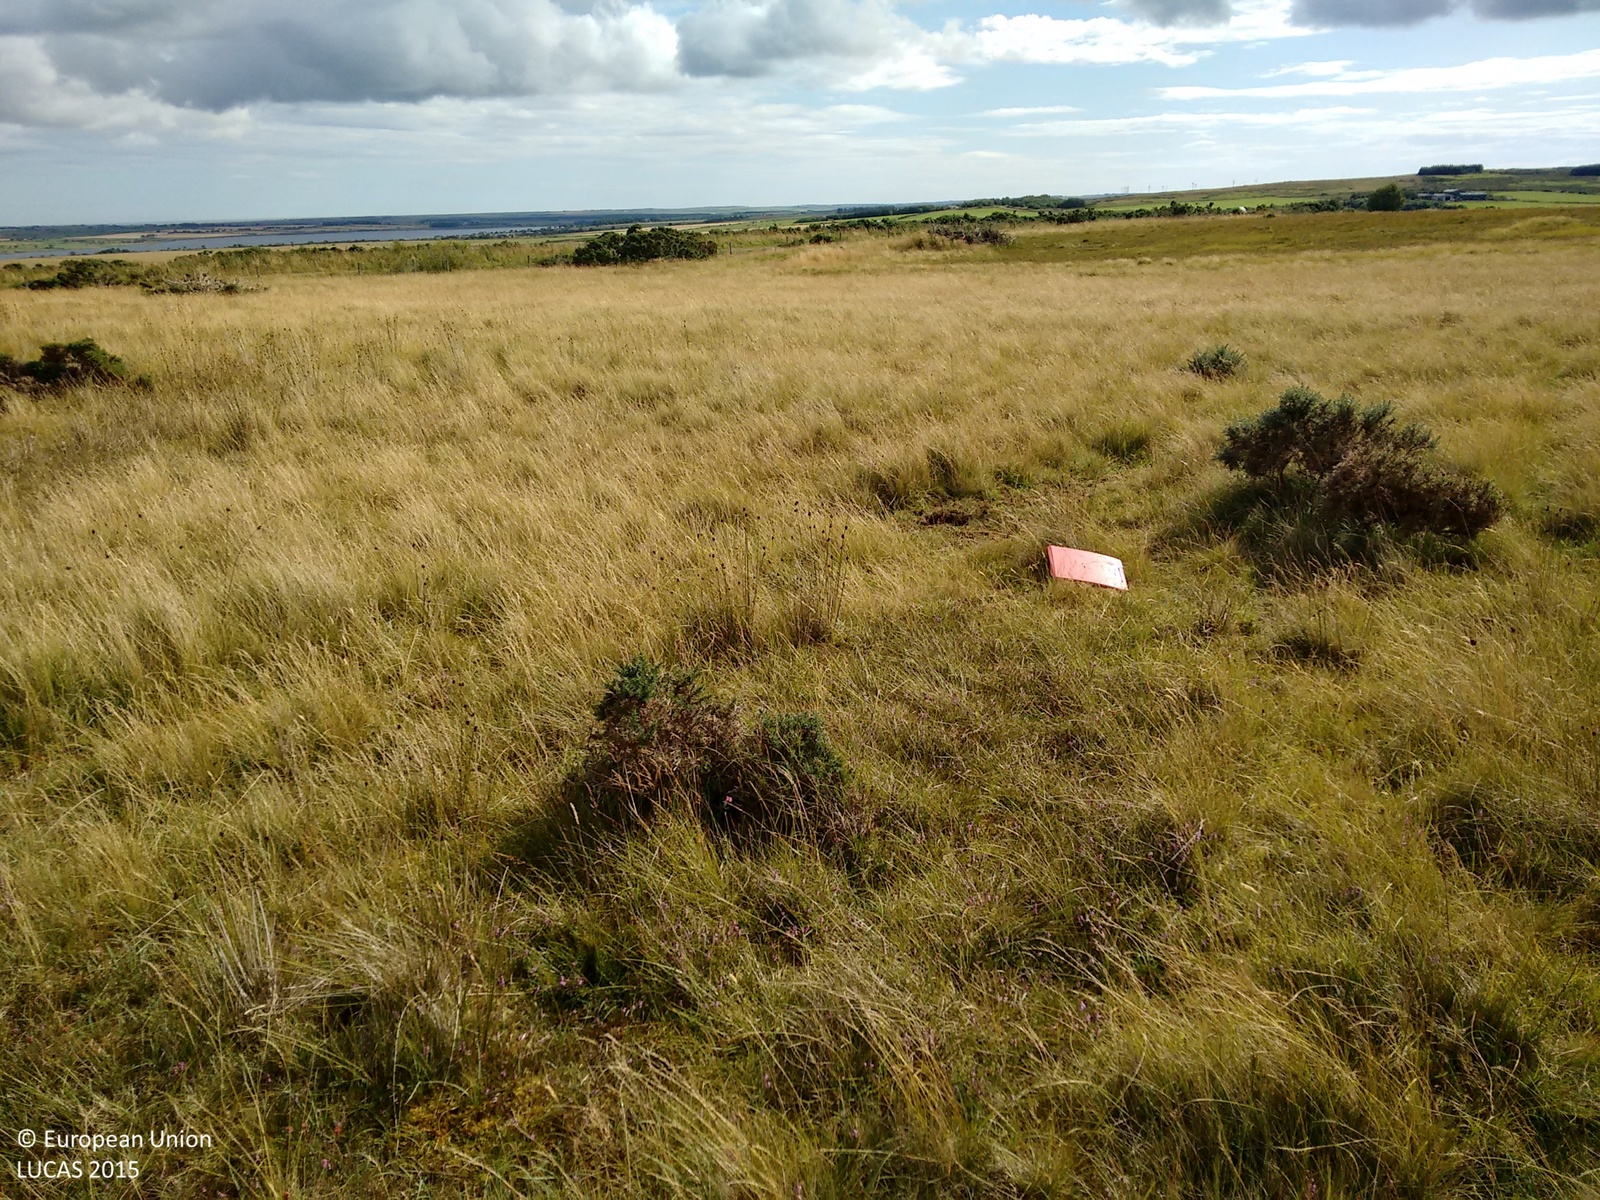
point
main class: Grassland
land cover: Grassland without tree/shrub cover
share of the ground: > 75 %
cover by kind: herbaceous plants 95 %, shrubs 5 %
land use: Agriculture (excluding fallow land and kitchen gardens)
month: August
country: GB
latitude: 58.4778
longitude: -3.3870
